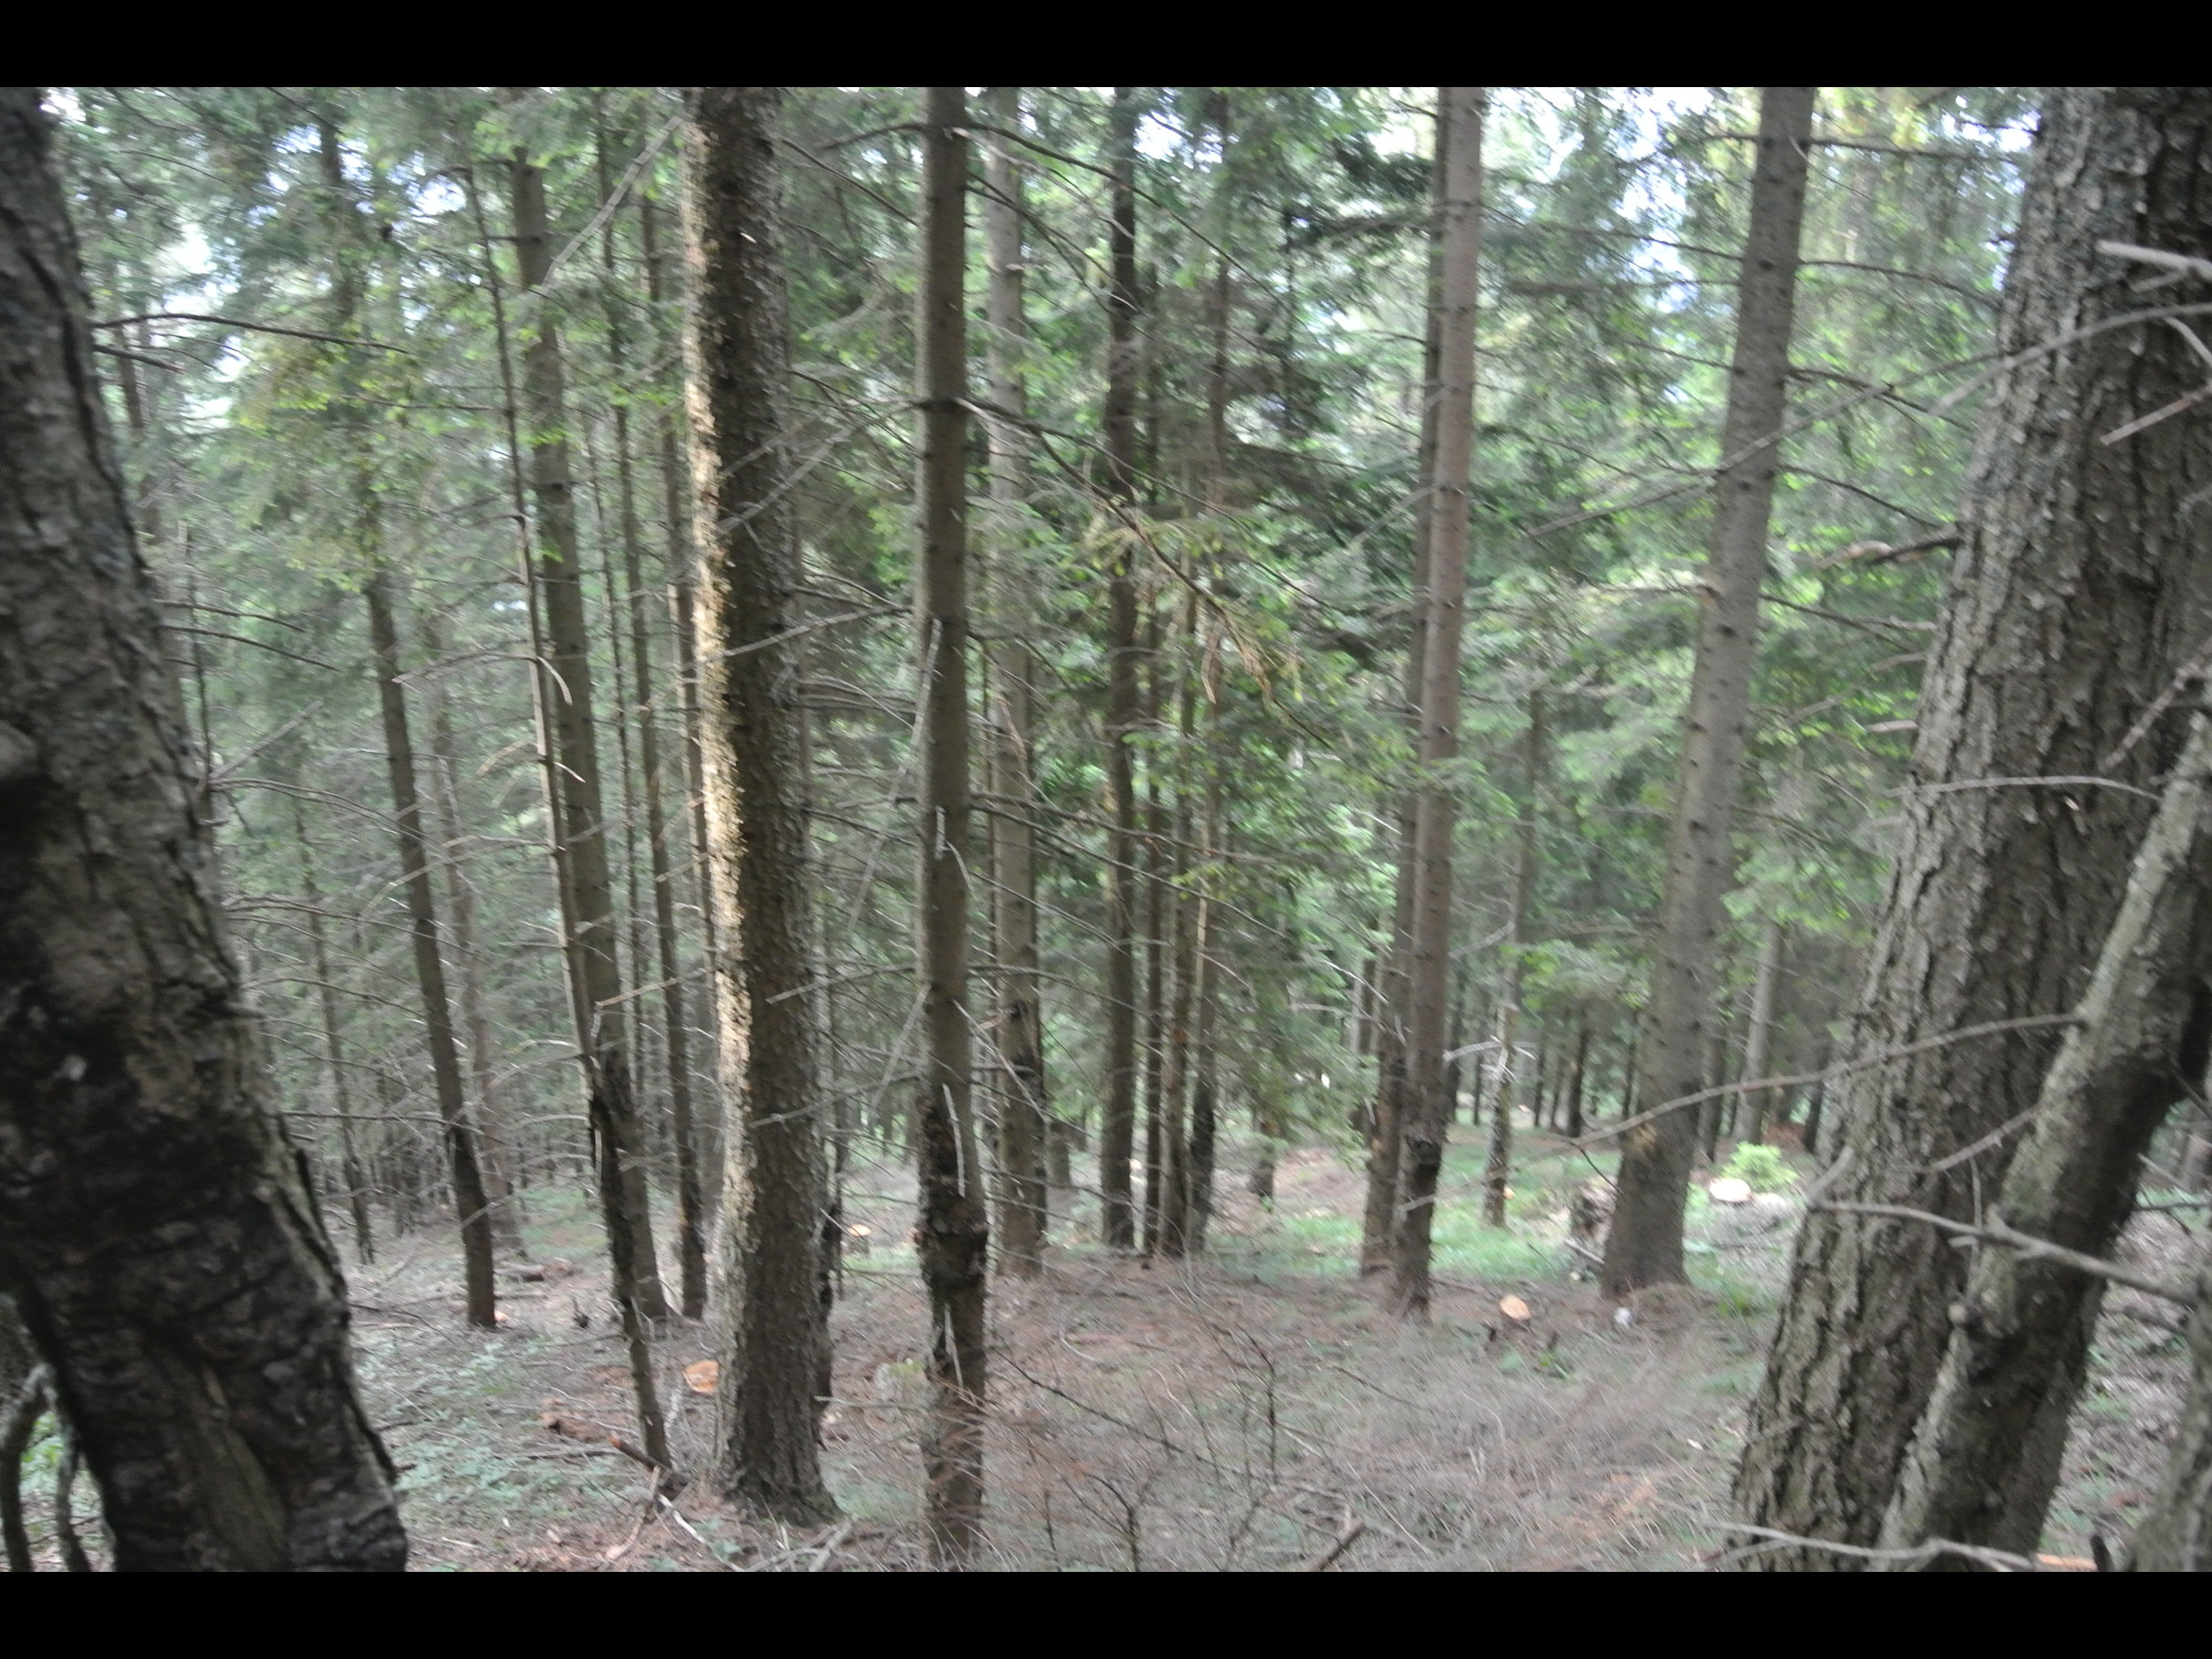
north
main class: Woodland
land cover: Spruce dominated coniferous woodland
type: alpine coniferous forest
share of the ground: > 75 %
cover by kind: coniferous forest trees 95 %, herbaceous plants 5 %
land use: Forestry
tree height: > 5 m
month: June
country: AT
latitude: 47.8190
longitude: 15.7855
